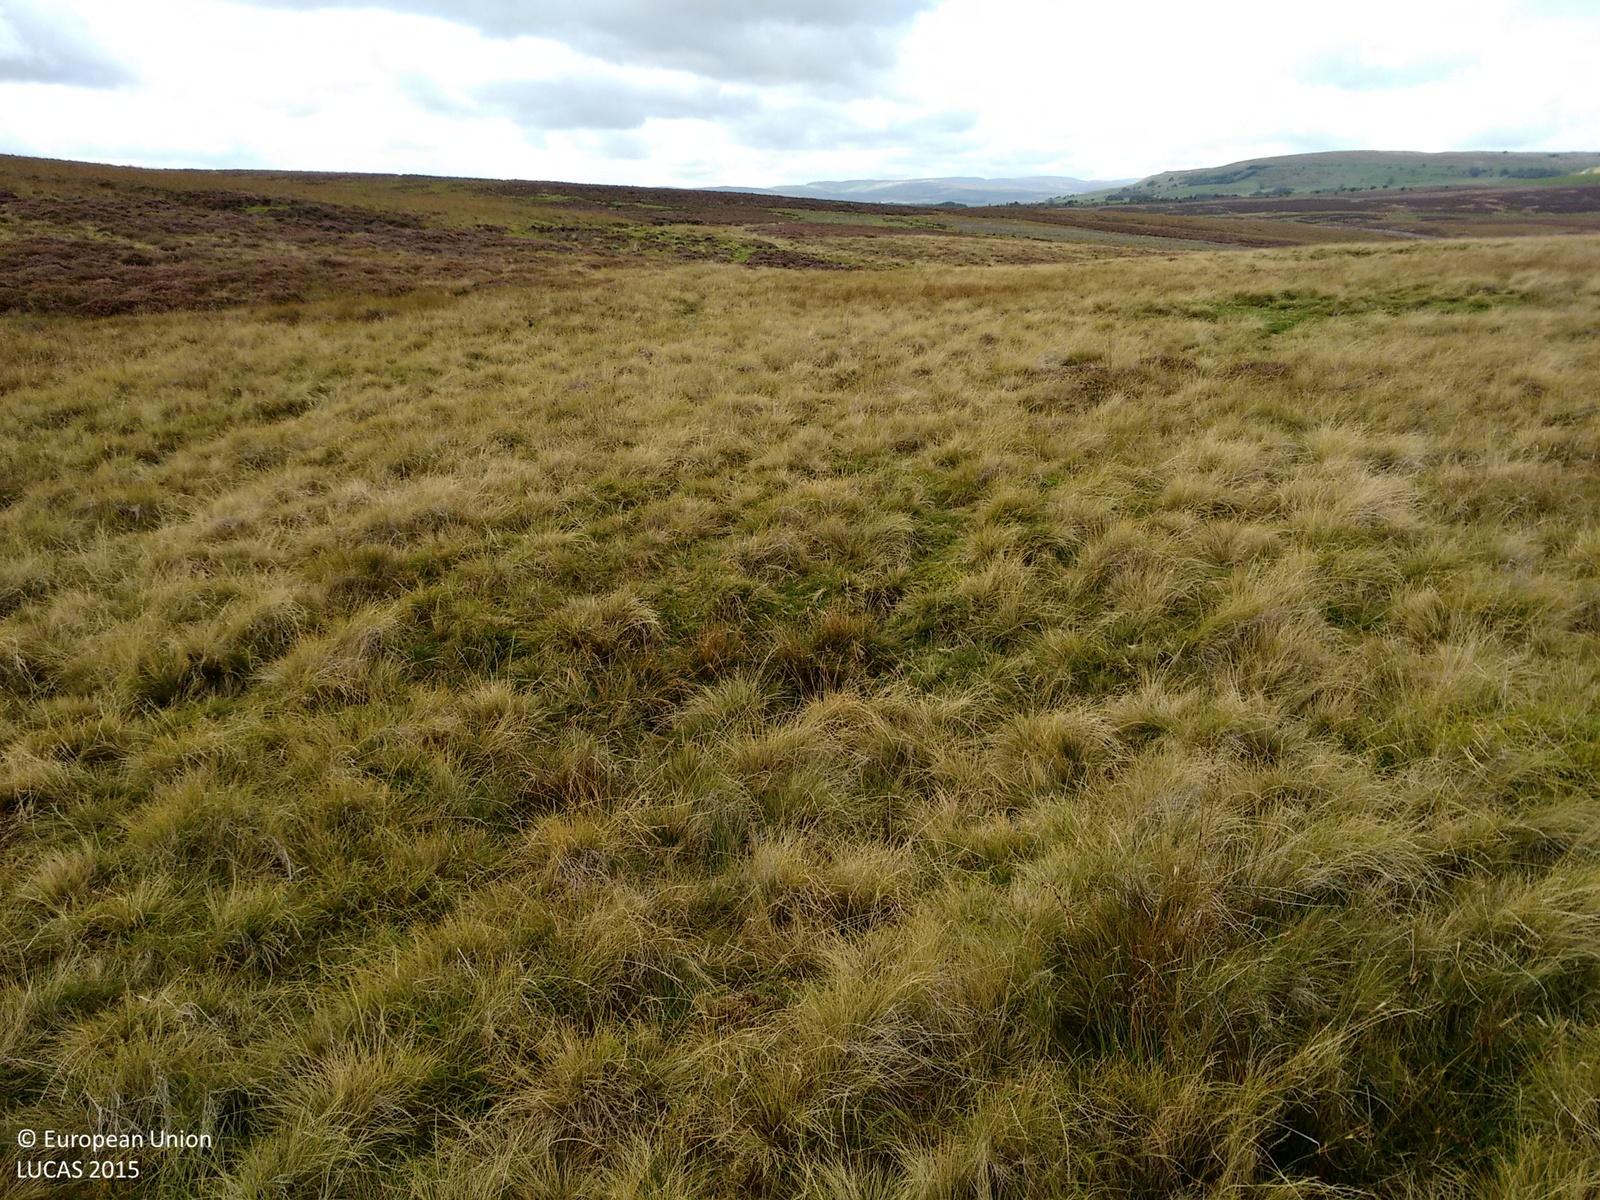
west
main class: Grassland
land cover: Grassland without tree/shrub cover
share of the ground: > 75 %
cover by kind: herbaceous plants 100 %
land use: Agriculture (excluding fallow land and kitchen gardens)
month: September
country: GB
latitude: 54.4642
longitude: -2.4830
